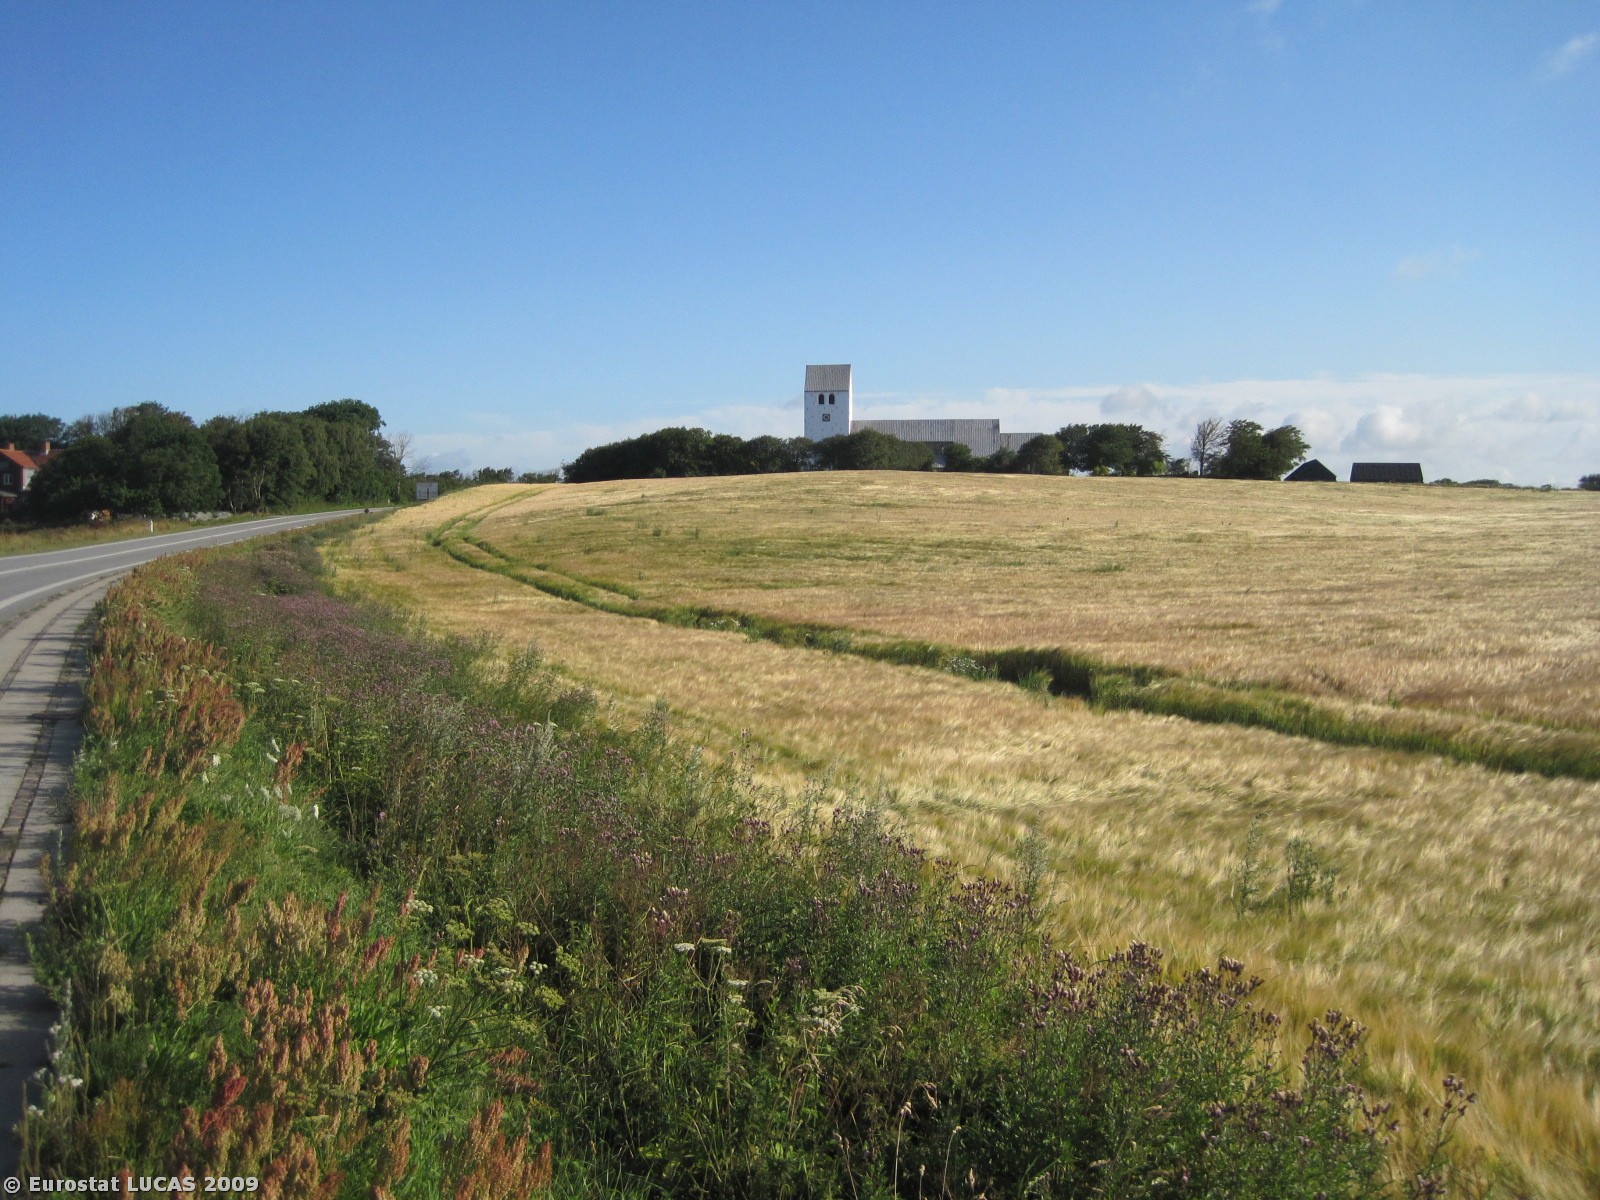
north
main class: Cropland
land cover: Barley
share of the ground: > 75 %
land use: Agriculture (excluding fallow land and kitchen gardens)
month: July
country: DK
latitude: 56.7701
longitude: 8.3170
